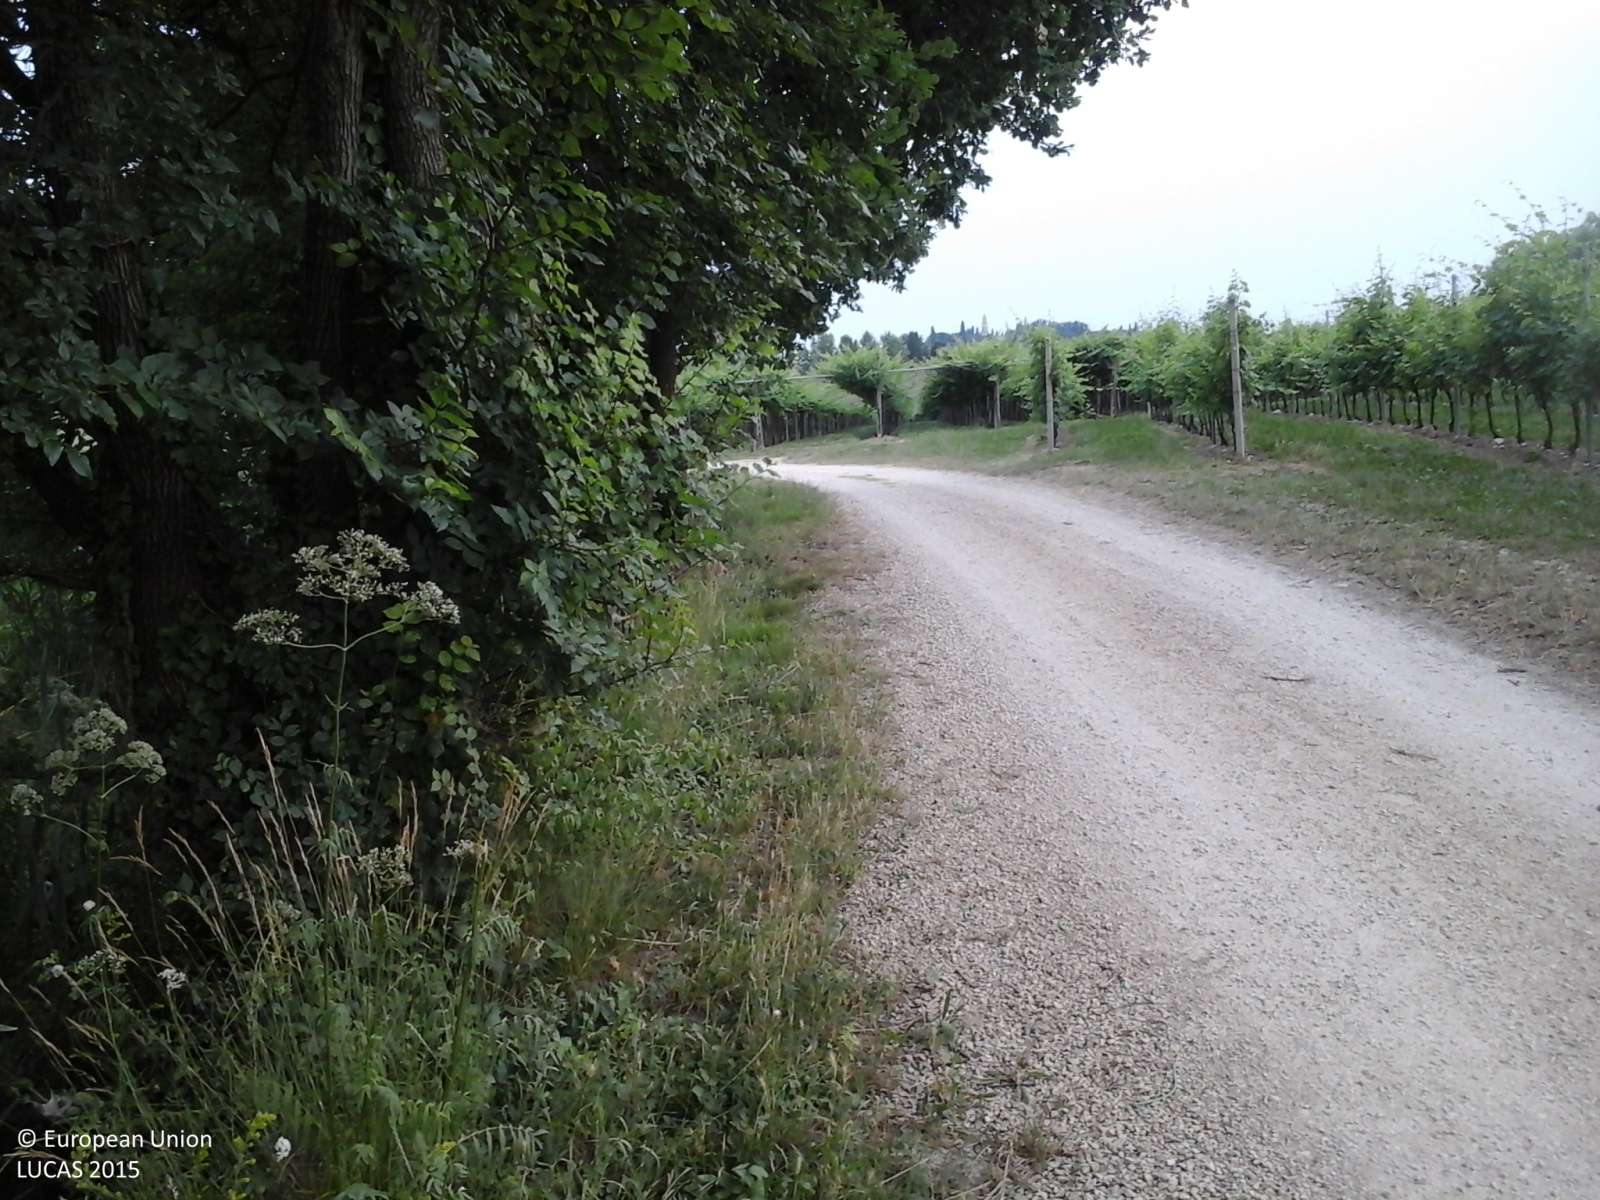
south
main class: Grassland
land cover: Grassland without tree/shrub cover
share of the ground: > 75 %
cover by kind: herbaceous plants 100 %
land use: Agriculture (excluding fallow land and kitchen gardens)
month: June
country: IT
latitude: 45.4837
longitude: 10.7536
